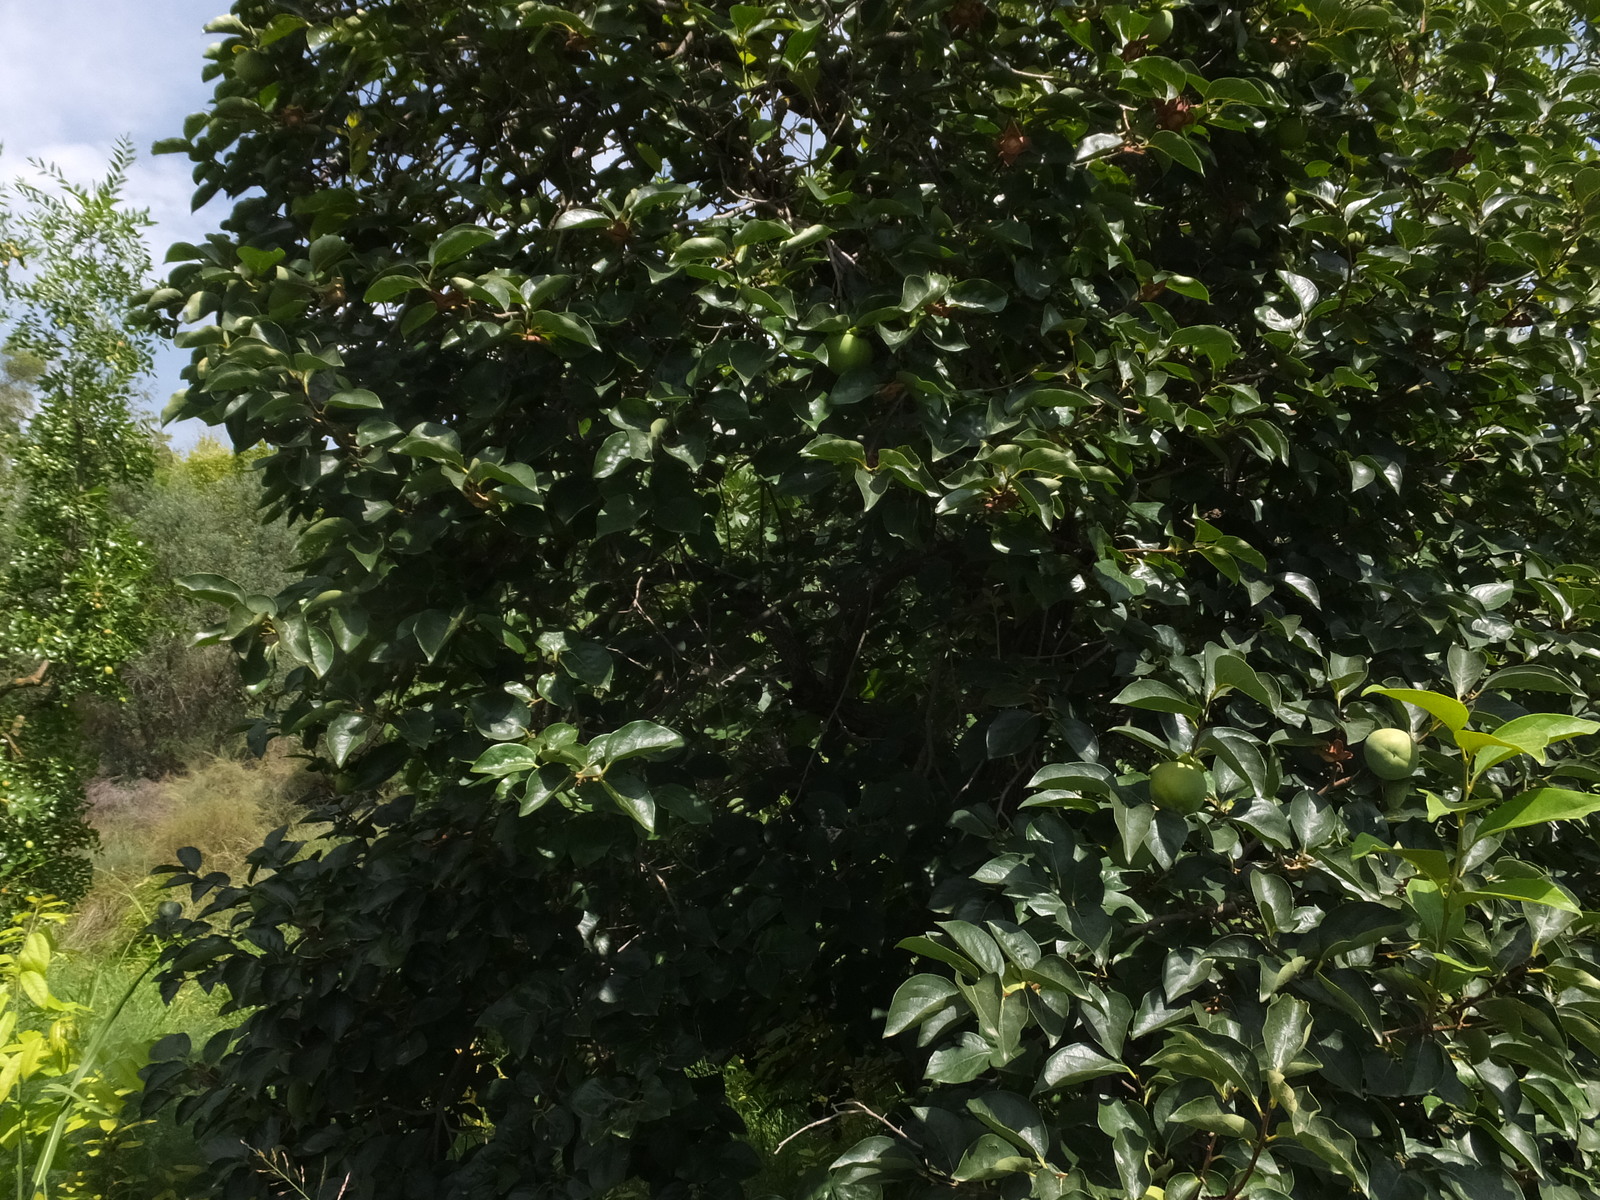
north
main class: Grassland
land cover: Grassland without tree/shrub cover
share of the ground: > 75 %
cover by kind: herbaceous plants 100 %
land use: Semi-natural and natural areas not in use
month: August
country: ES
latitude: 41.5747
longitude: 0.3561
